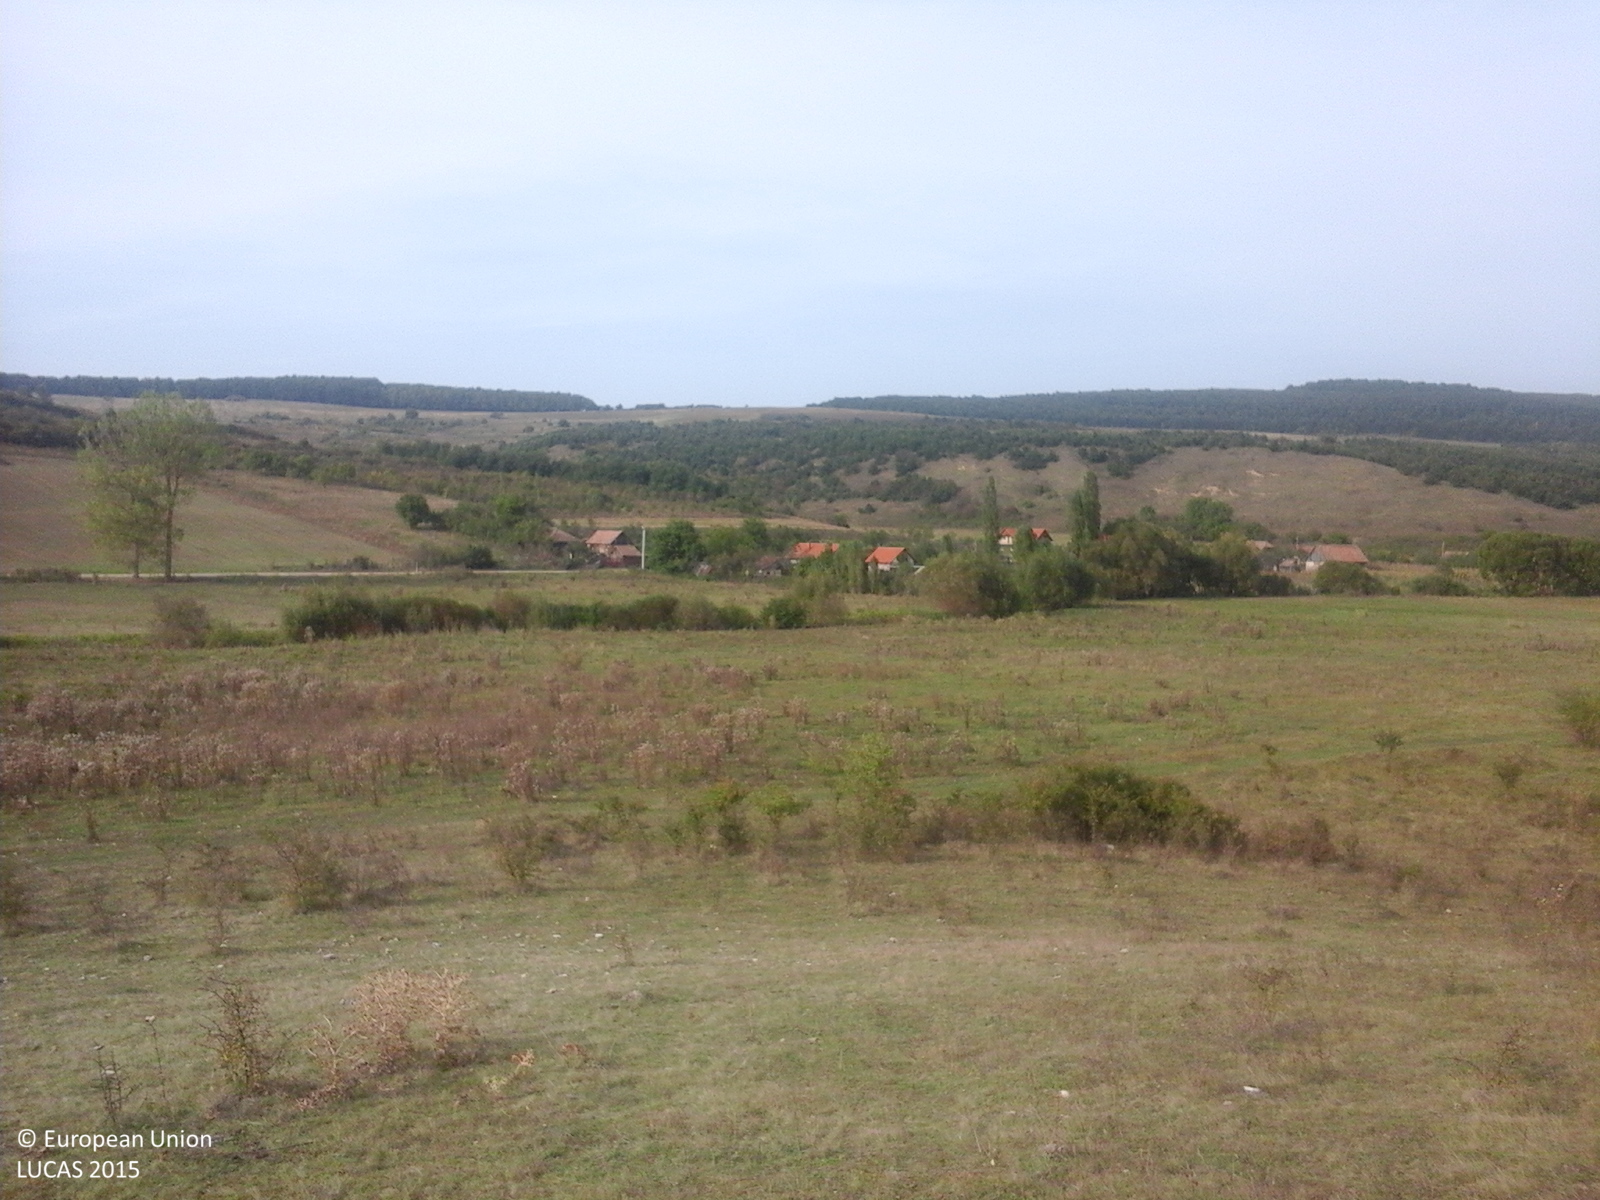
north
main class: Grassland
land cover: Grassland with sparse tree/shrub cover
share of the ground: > 75 %
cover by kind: herbaceous plants 85 %, shrubs 10 %, broadleaved forest trees 5 %
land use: Agriculture (excluding fallow land and kitchen gardens)
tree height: < 5 m
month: September
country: RO
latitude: 46.9216
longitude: 23.5847
